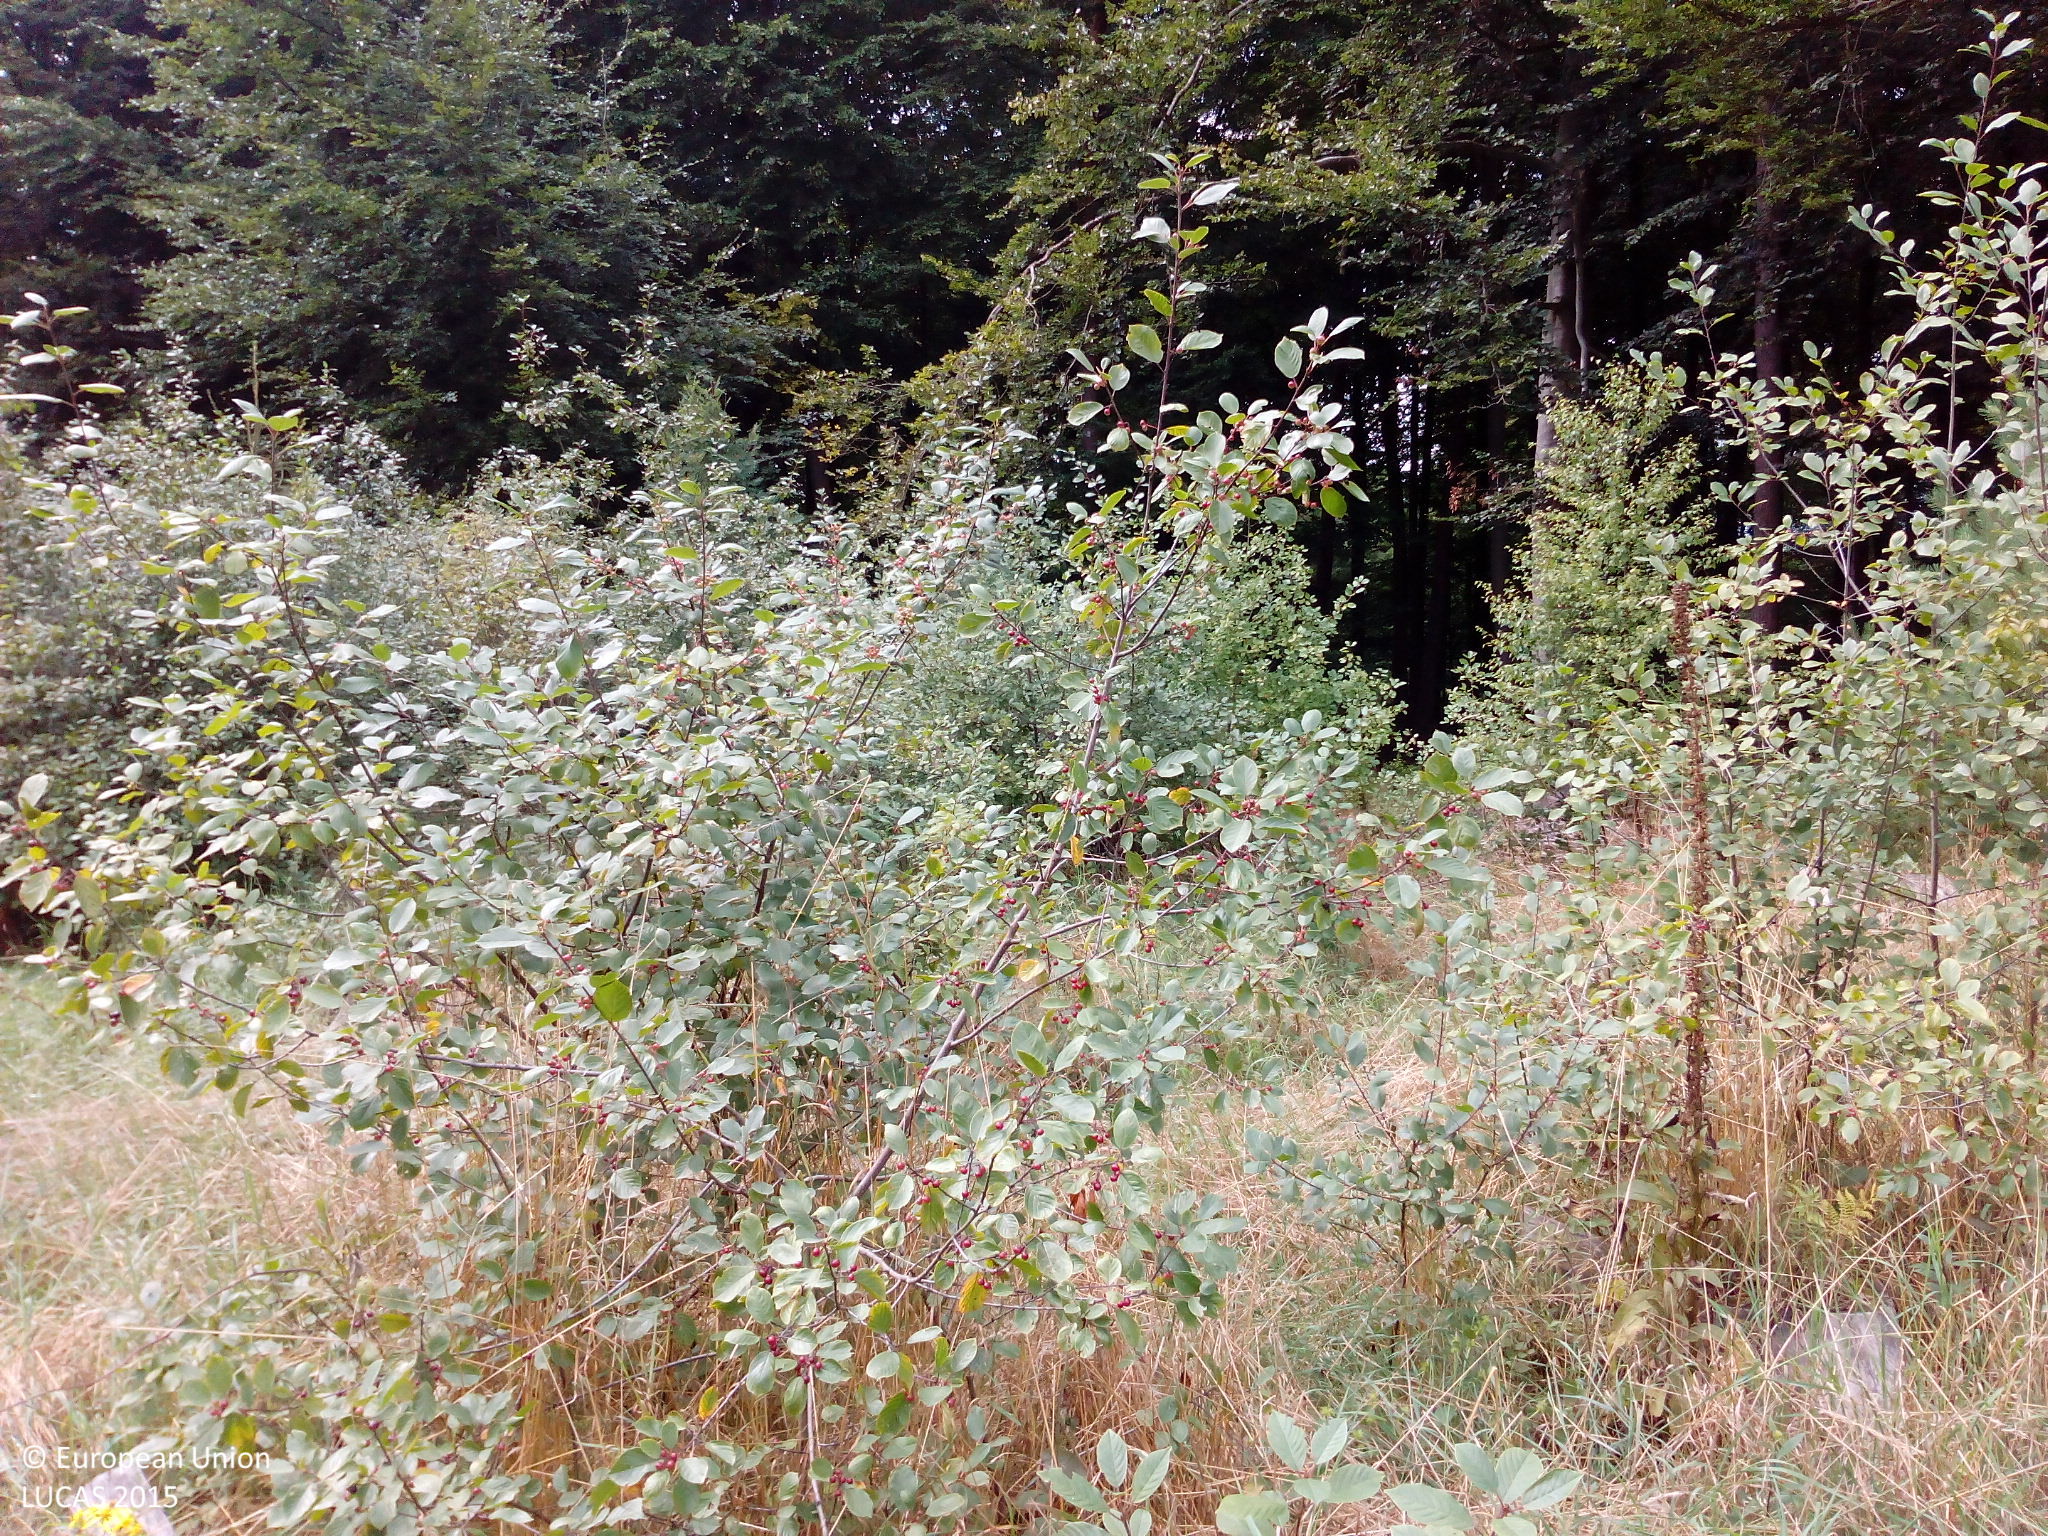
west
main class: Shrubland
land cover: Shrubland with sparse tree cover
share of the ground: > 75 %
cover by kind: shrubs 70 %, herbaceous plants 25 %, broadleaved forest trees 5 %
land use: Forestry
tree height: < 5 m
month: August
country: DE
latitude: 50.0861
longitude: 7.5545
